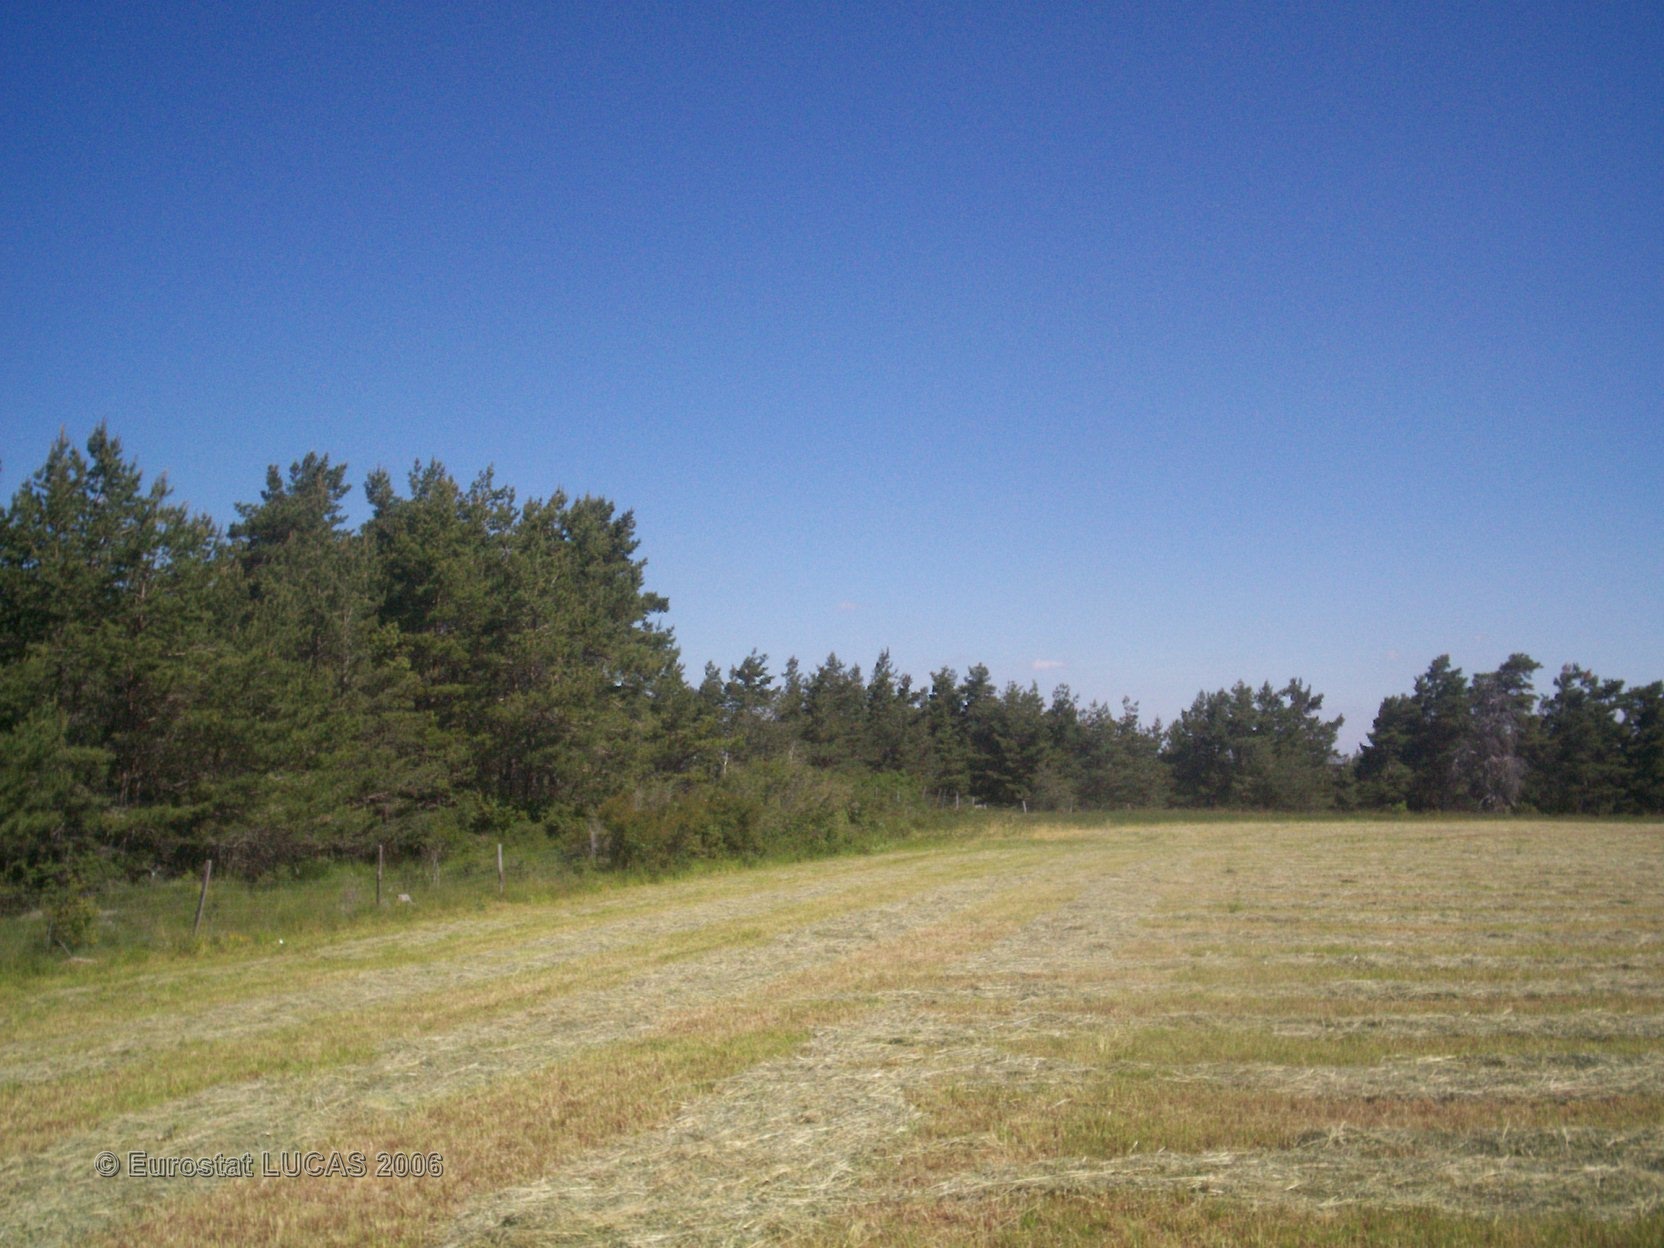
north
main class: Cropland
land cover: Other leguminous and mixtures for fodder
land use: Agriculture (excluding fallow land and kitchen gardens)
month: June
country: FR
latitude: 44.1775
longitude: 3.4145
